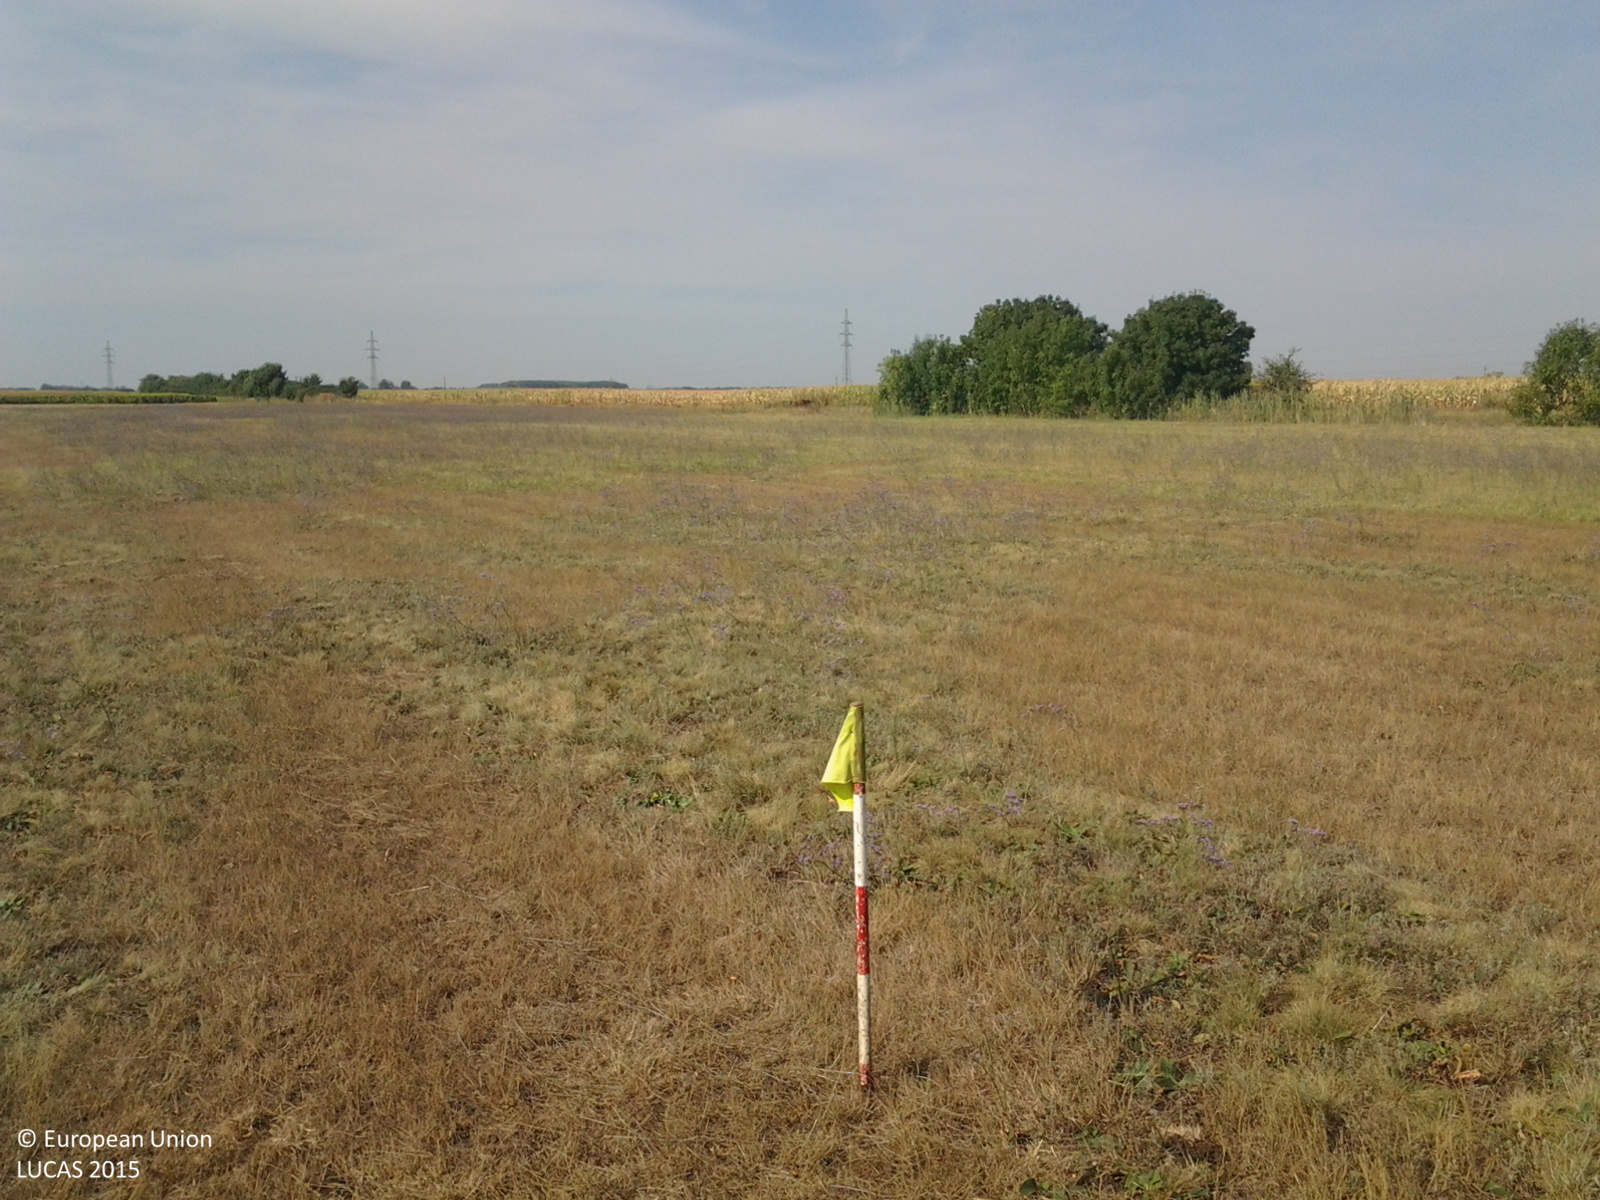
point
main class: Grassland
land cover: Grassland without tree/shrub cover
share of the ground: > 75 %
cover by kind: herbaceous plants 100 %
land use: Agriculture (excluding fallow land and kitchen gardens)
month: August
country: HU
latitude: 47.4465
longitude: 19.7443
